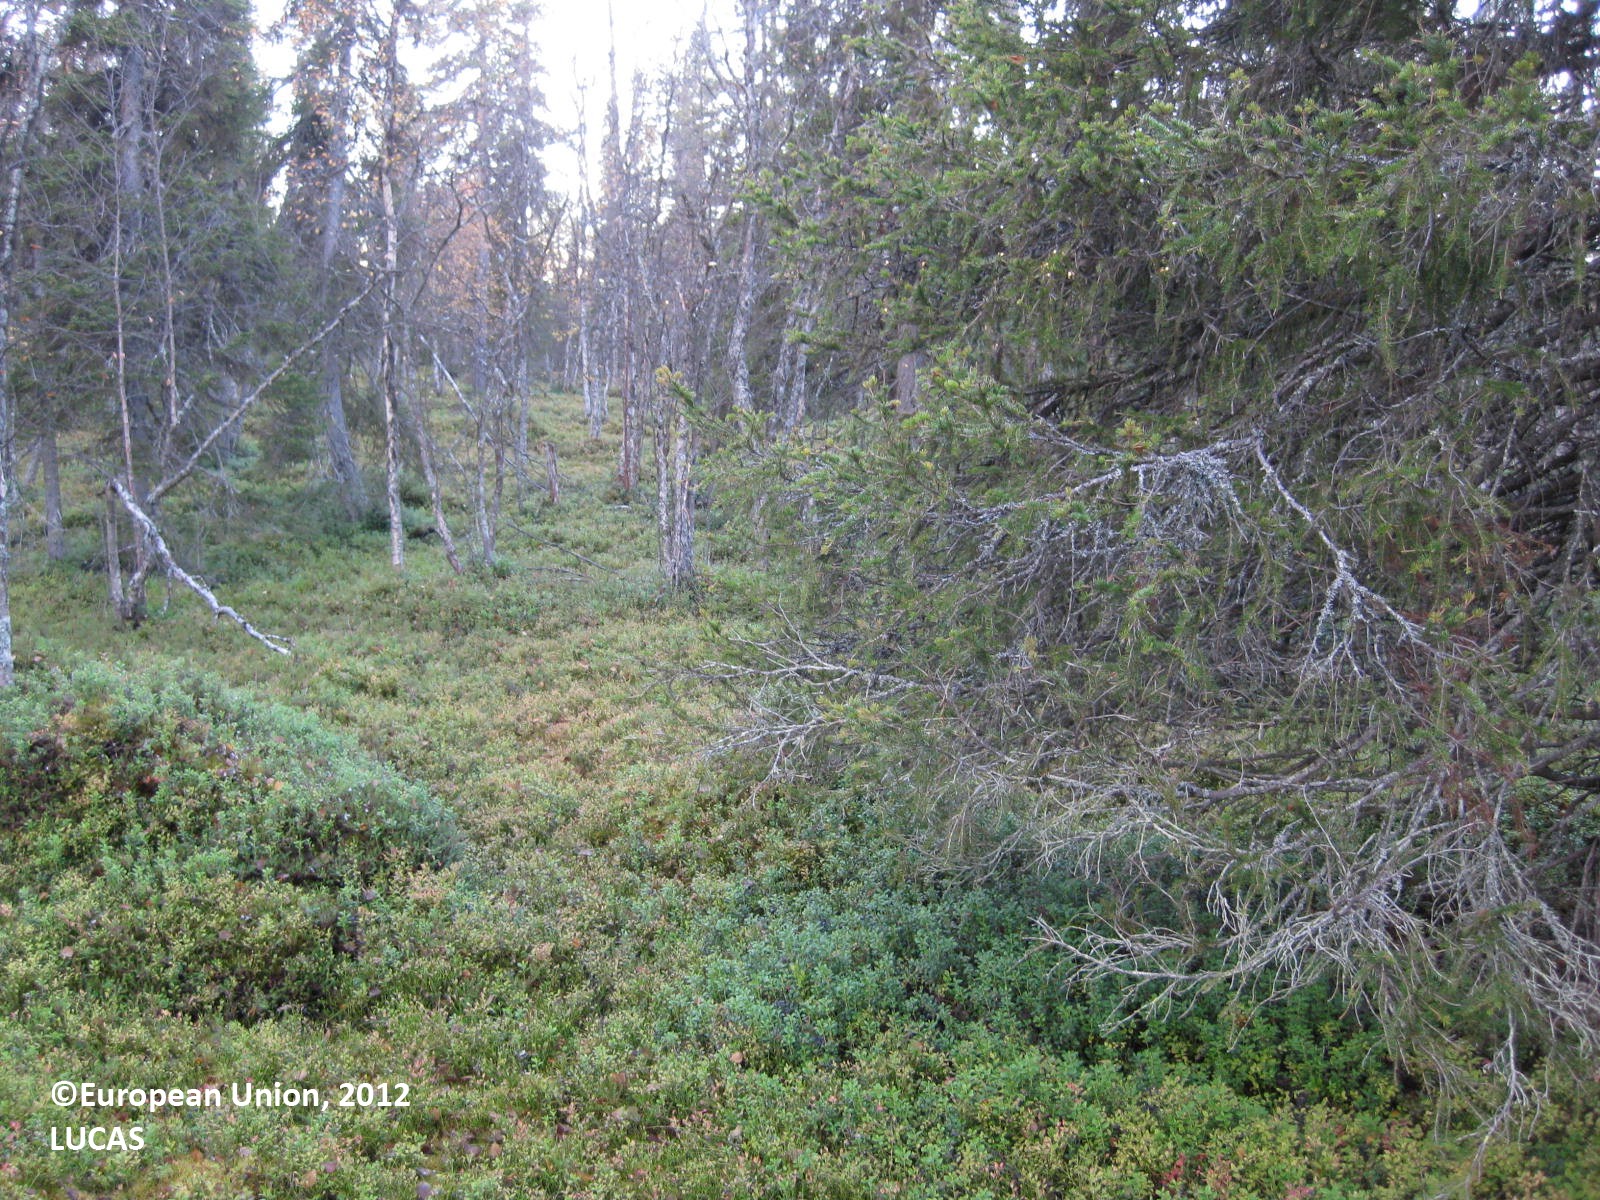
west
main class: Woodland
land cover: Other mixed woodland
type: boreal forest
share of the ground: > 75 %
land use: Forestry
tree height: > 5 m
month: September
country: FI
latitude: 68.0216
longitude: 24.1683
